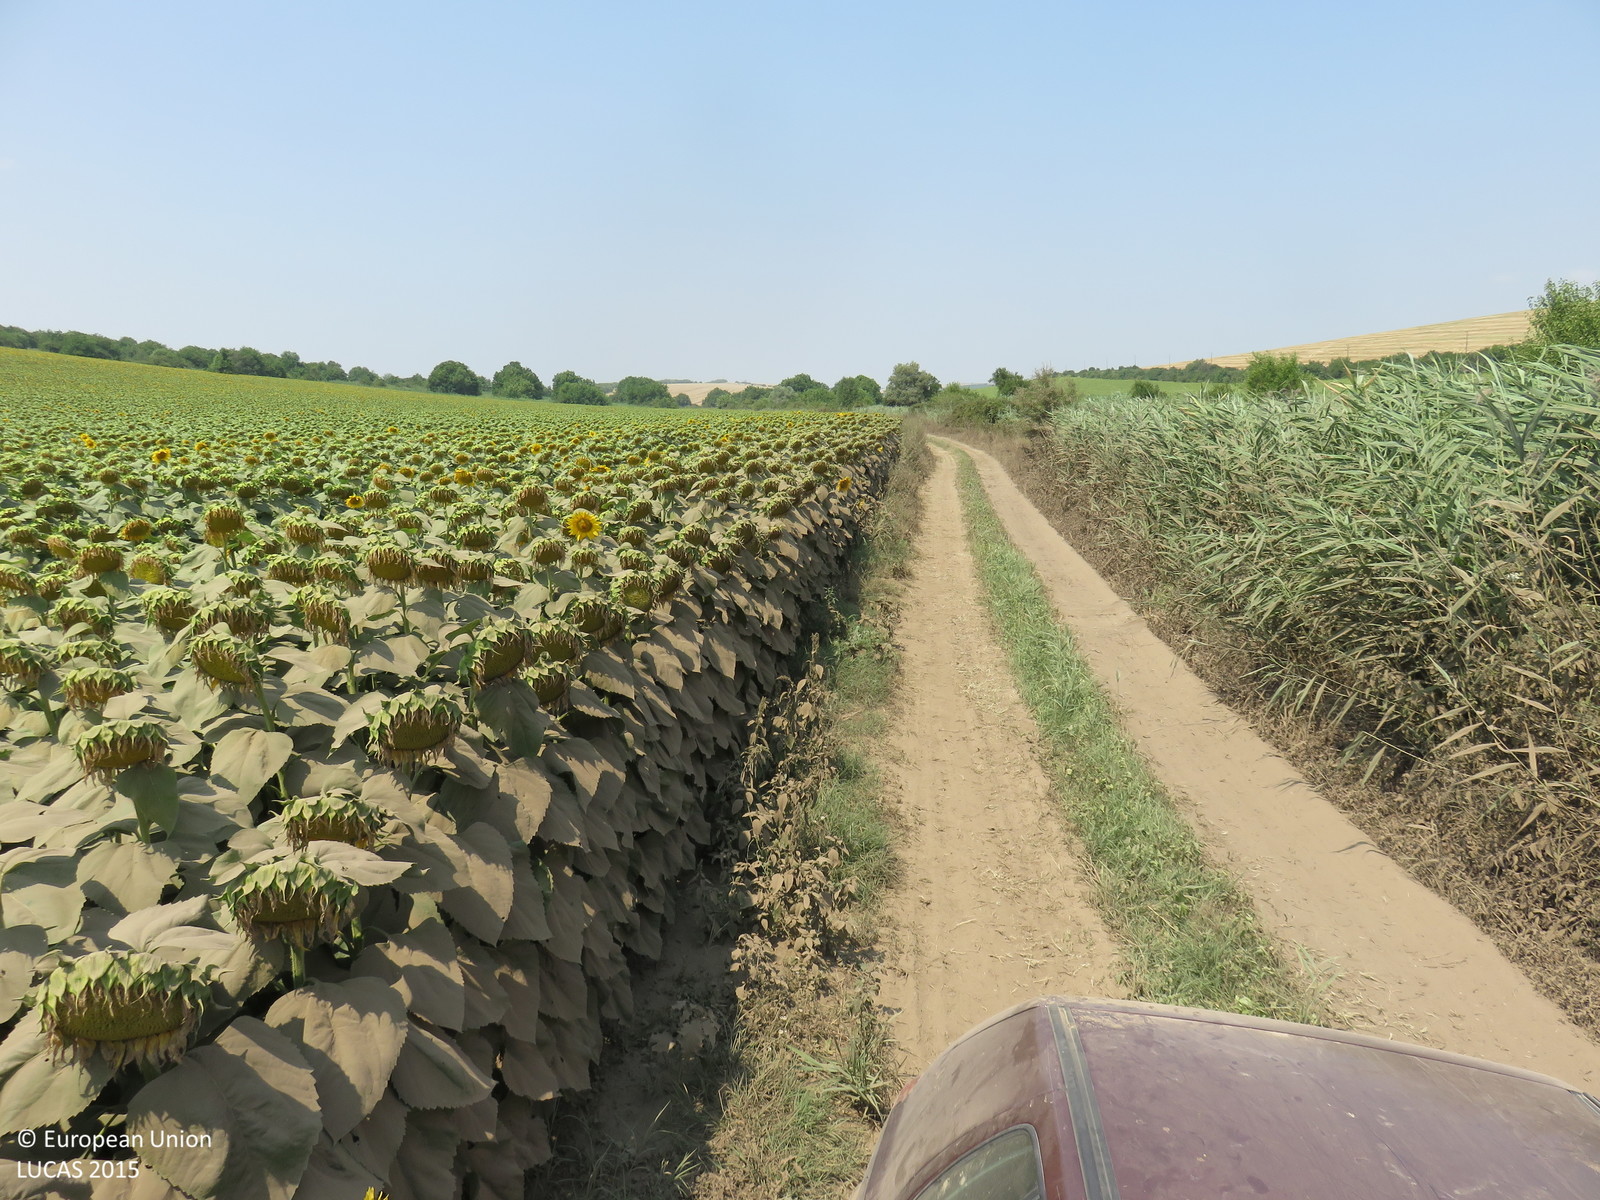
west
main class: Cropland
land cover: Sunflower
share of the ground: > 75 %
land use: Agriculture (excluding fallow land and kitchen gardens)
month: July
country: BG
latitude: 43.5441
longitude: 25.1366
